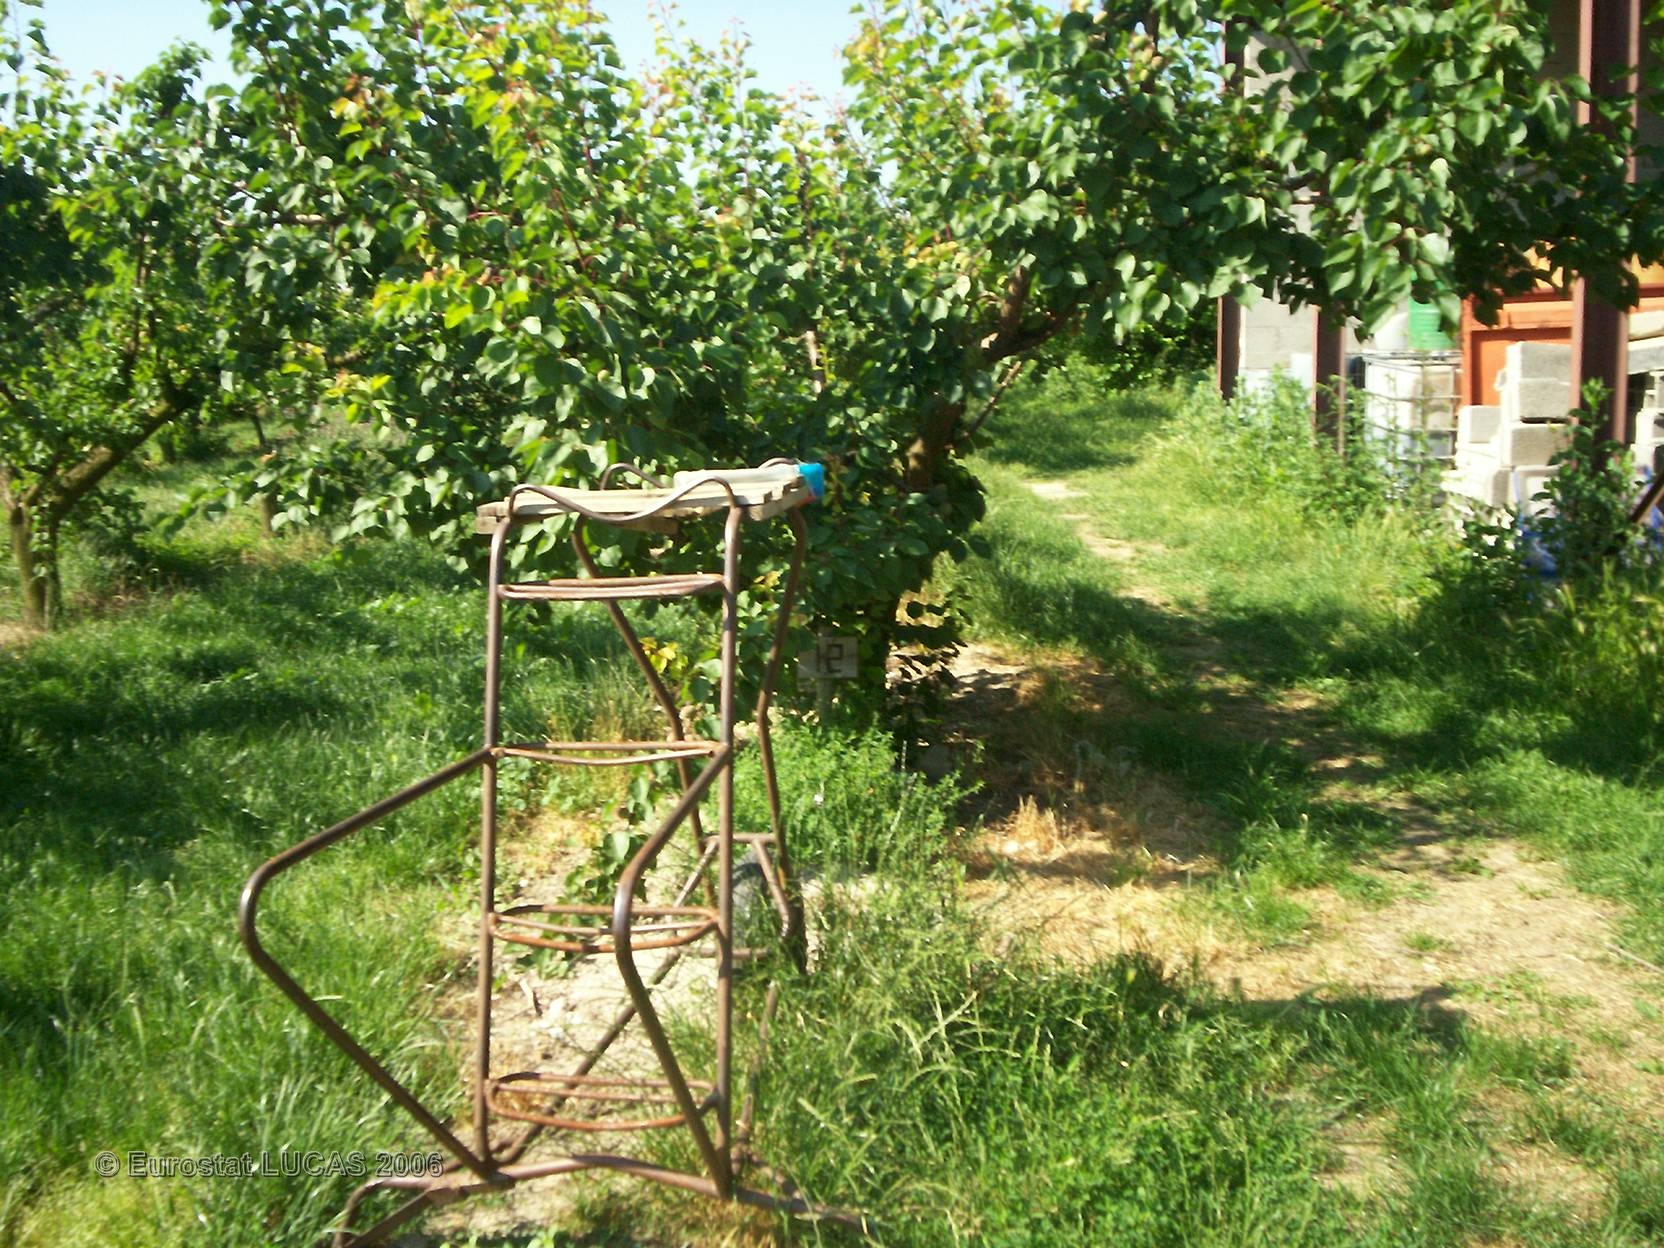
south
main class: Cropland
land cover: Other fruit trees and berries
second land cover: Grassland with sparse tree/shrub cover
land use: Agriculture (excluding fallow land and kitchen gardens)
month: June
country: FR
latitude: 45.0723
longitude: 4.8611
